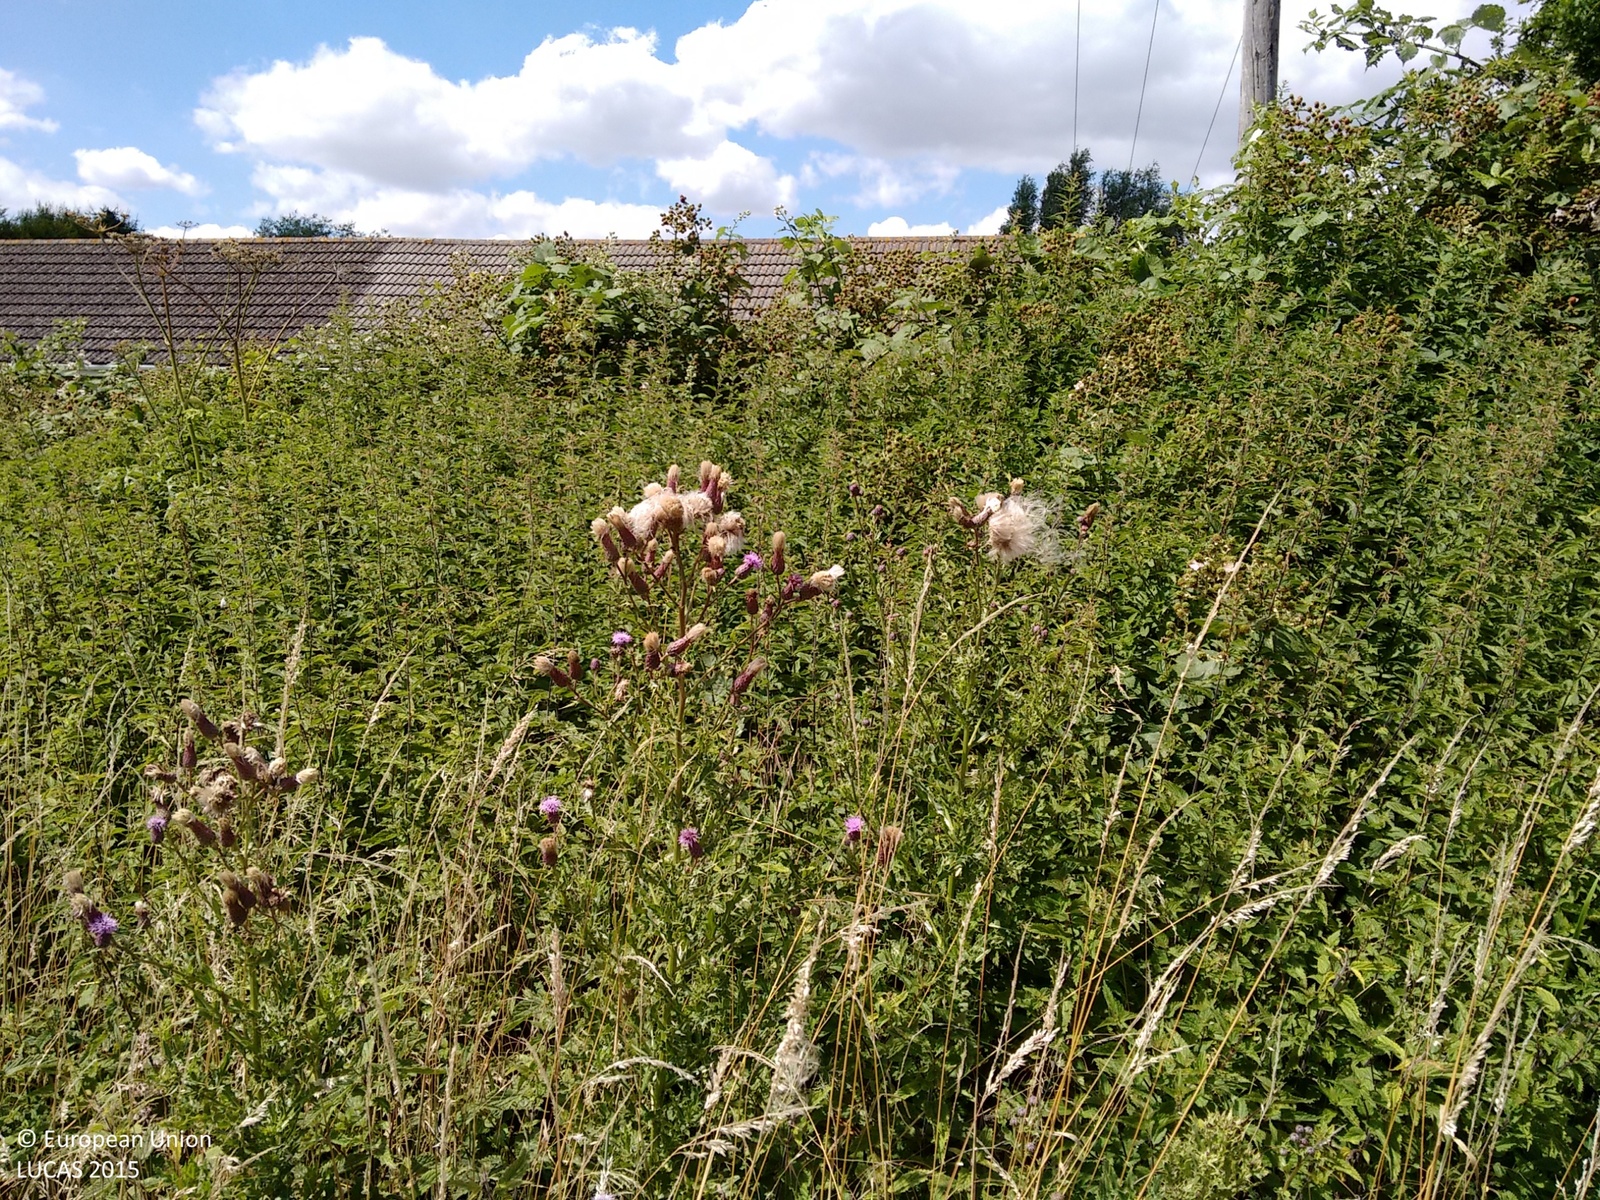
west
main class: Cropland
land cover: Barley
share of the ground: > 75 %
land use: Agriculture (excluding fallow land and kitchen gardens)
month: July
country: GB
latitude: 52.7316
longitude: 0.4201
